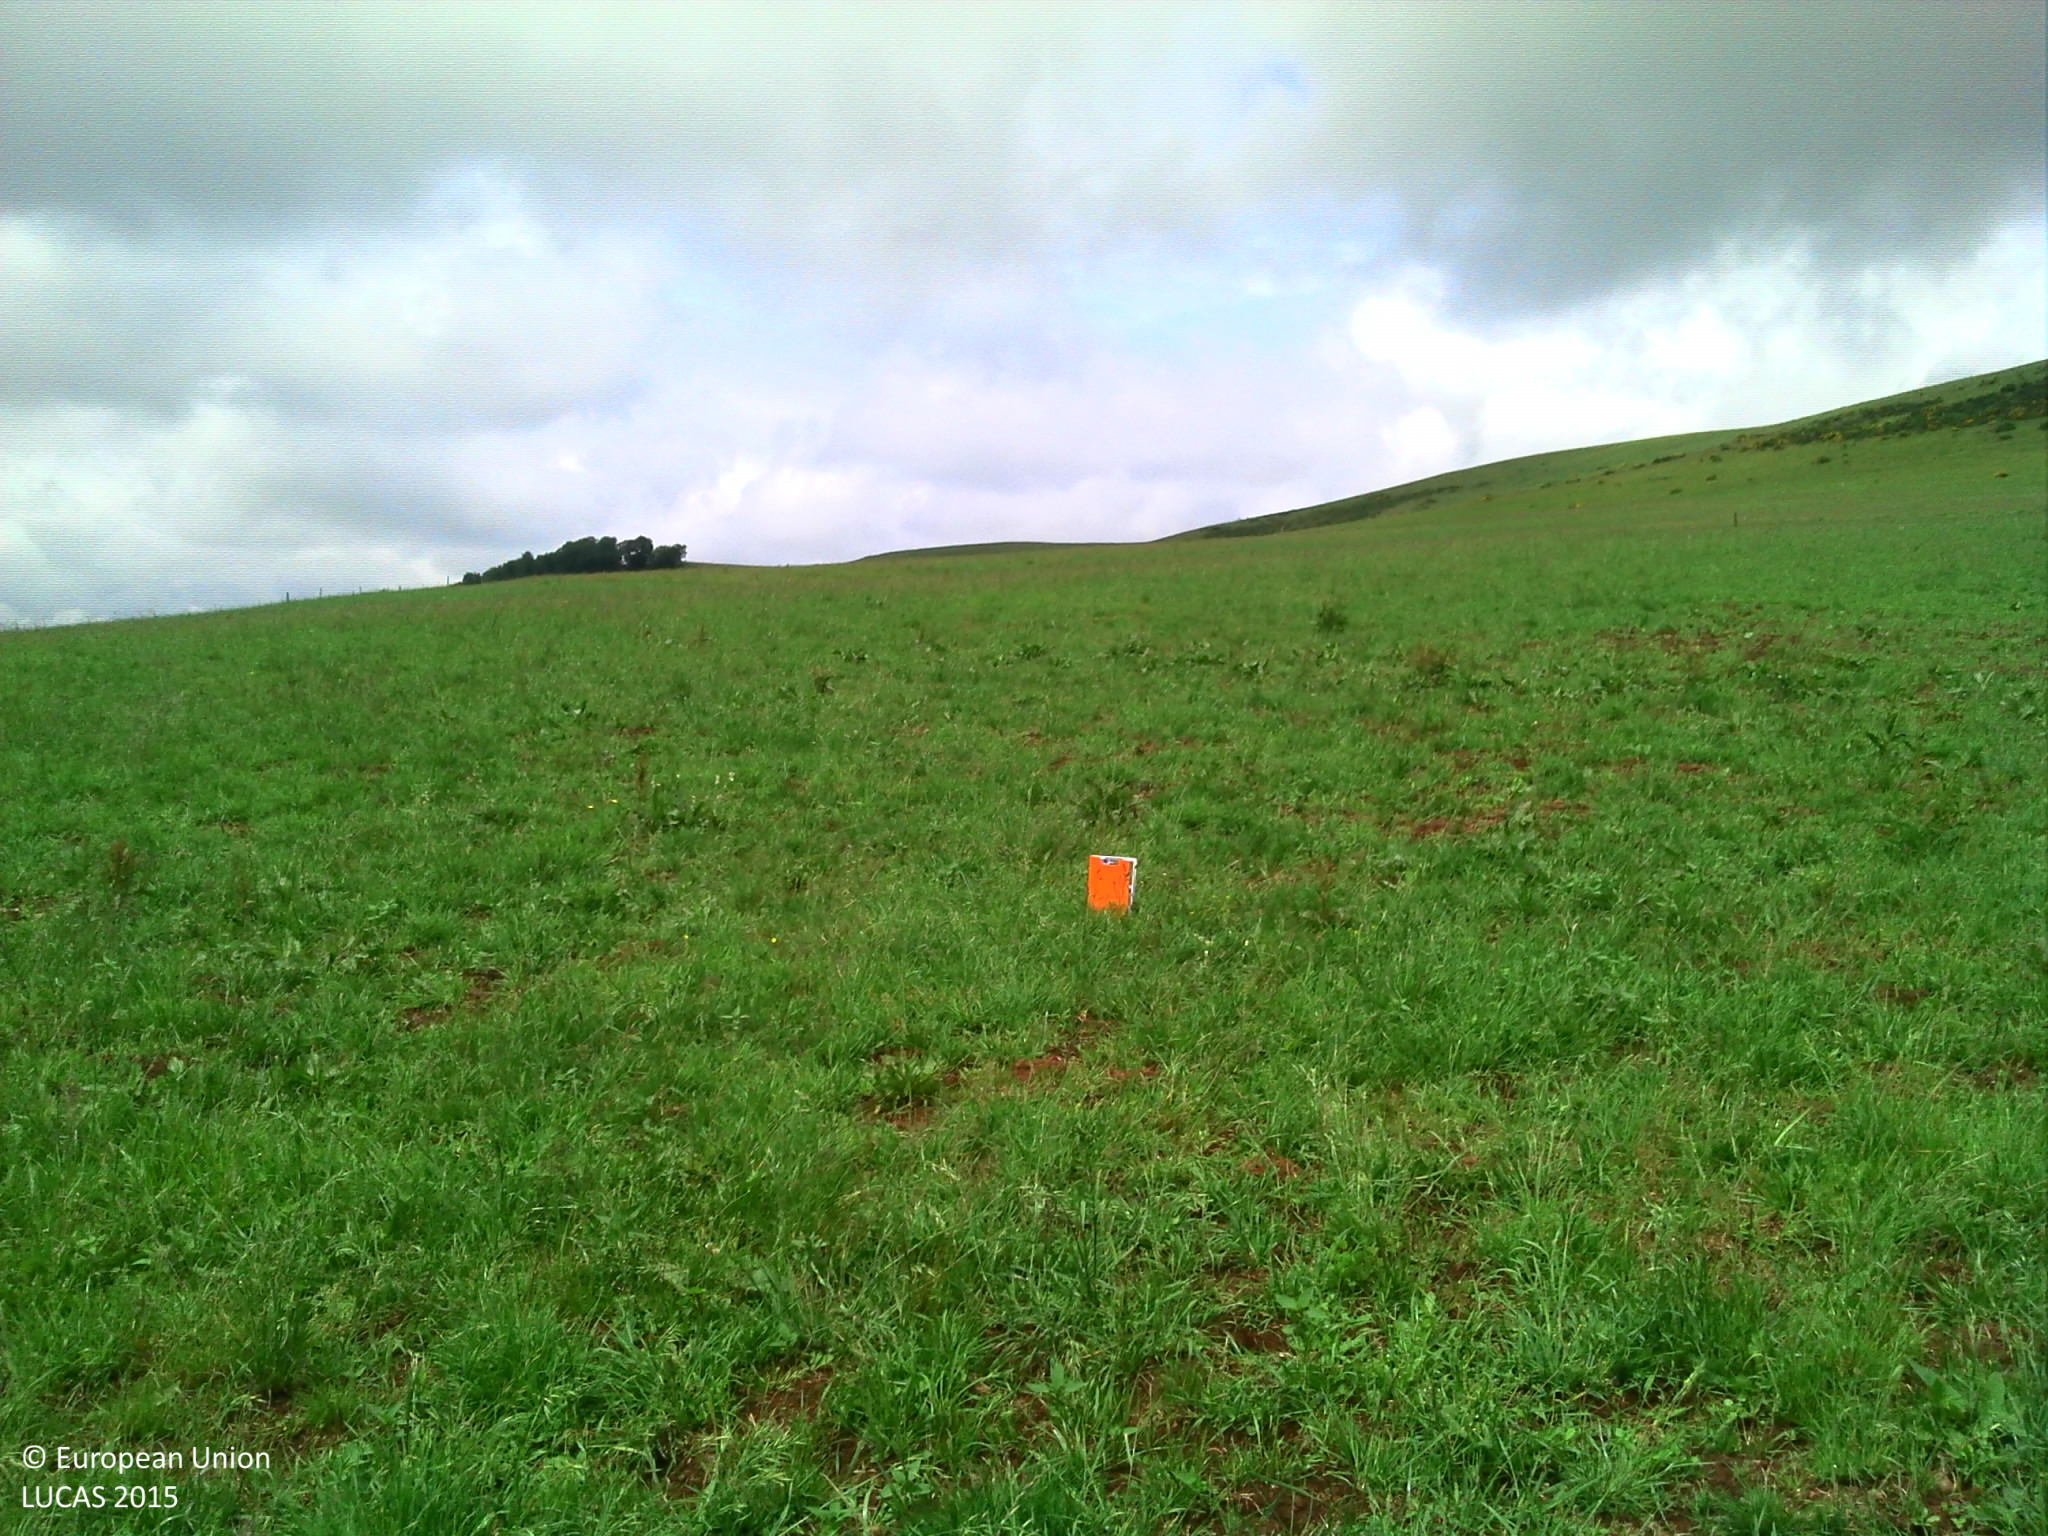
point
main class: Grassland
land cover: Grassland without tree/shrub cover
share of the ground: > 75 %
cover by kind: herbaceous plants 95 %, unconsolidated bare surface 5 %
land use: Agriculture (excluding fallow land and kitchen gardens)
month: June
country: FR
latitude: 45.2978
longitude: 2.8466
